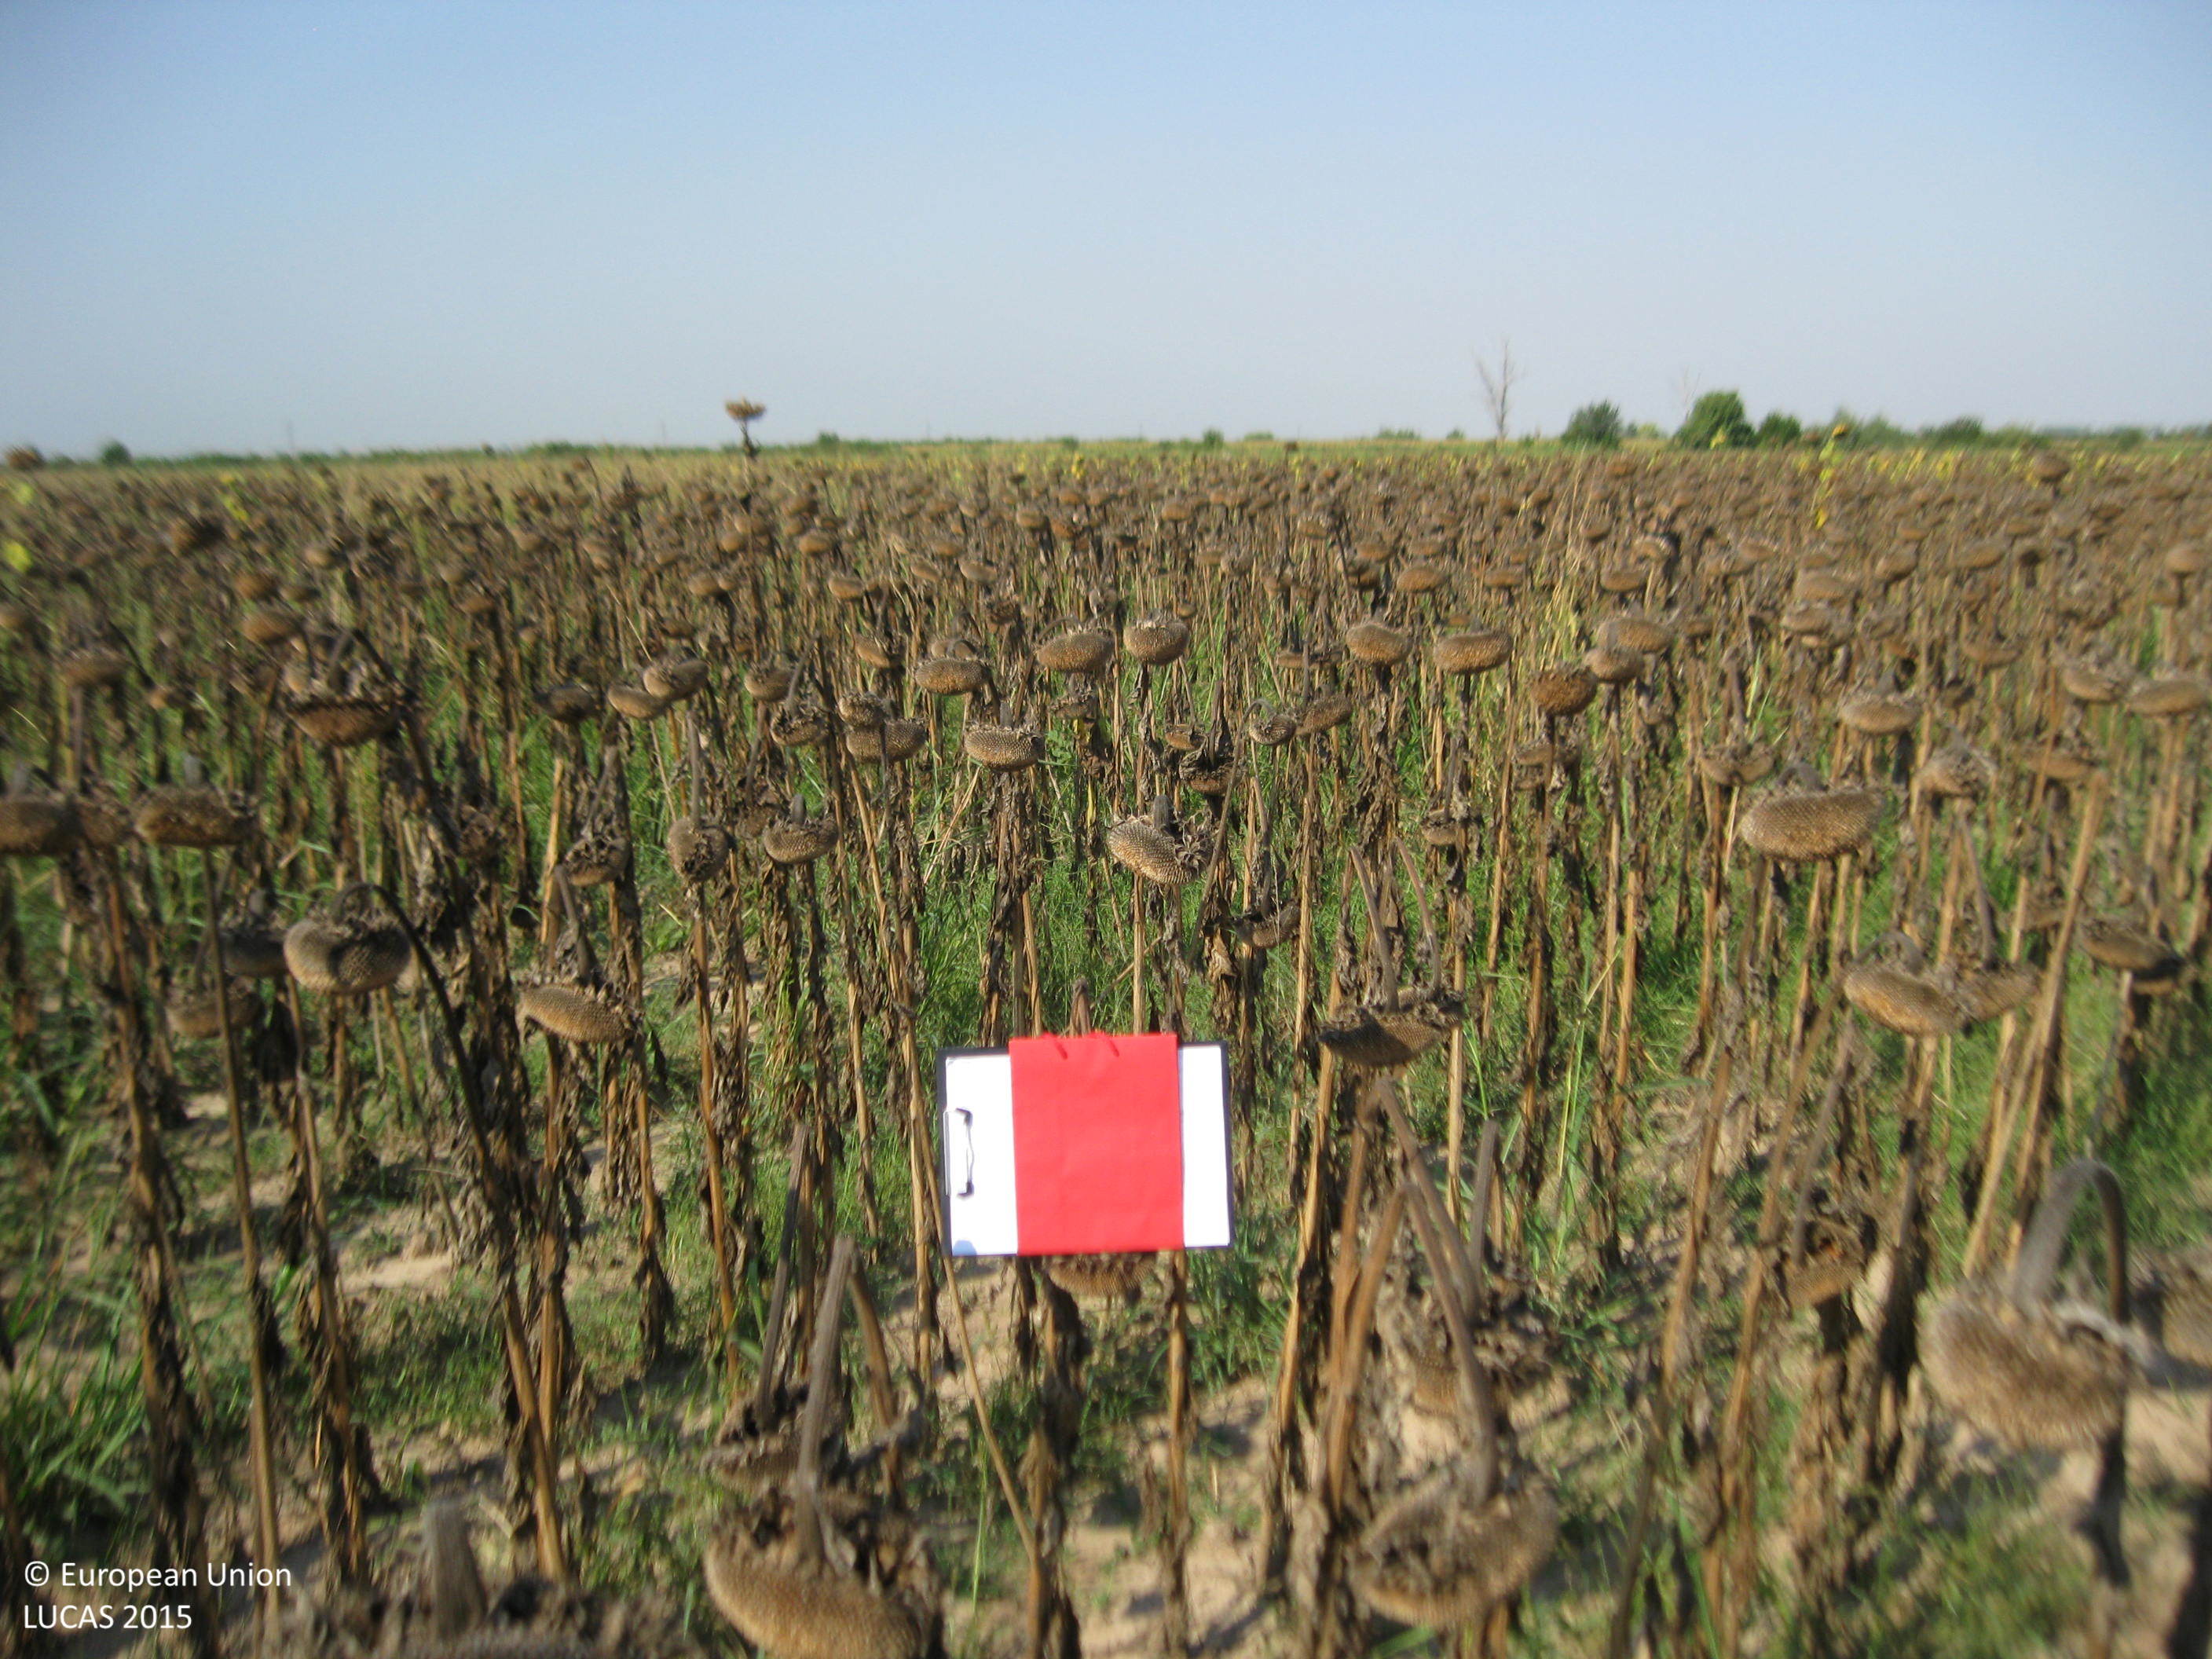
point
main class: Cropland
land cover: Sunflower
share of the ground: > 75 %
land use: Agriculture (excluding fallow land and kitchen gardens)
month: September
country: BG
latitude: 42.2624
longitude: 25.0049
